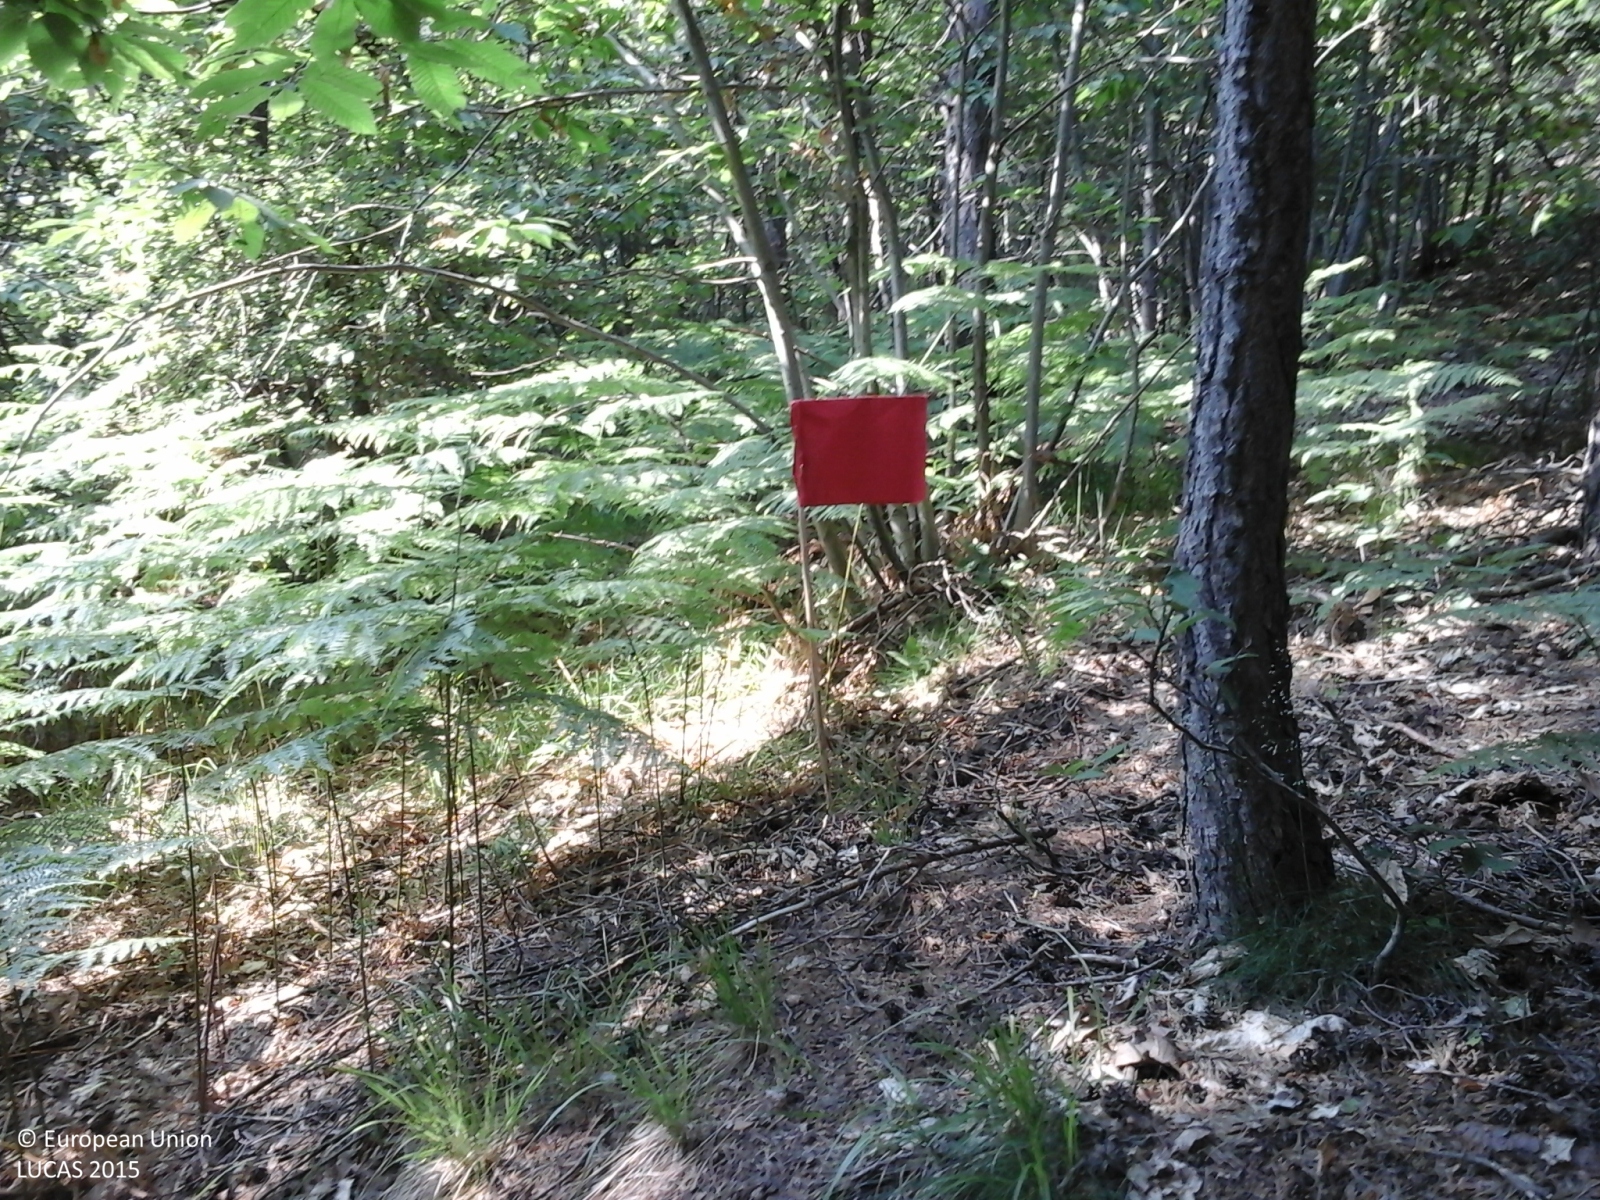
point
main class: Woodland
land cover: Broadleaved woodland
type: thermophilous deciduous forest
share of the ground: > 75 %
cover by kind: broadleaved forest trees 80 %, shrubs 20 %
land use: Forestry
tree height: > 5 m
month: June
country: IT
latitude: 44.5559
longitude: 8.4800
